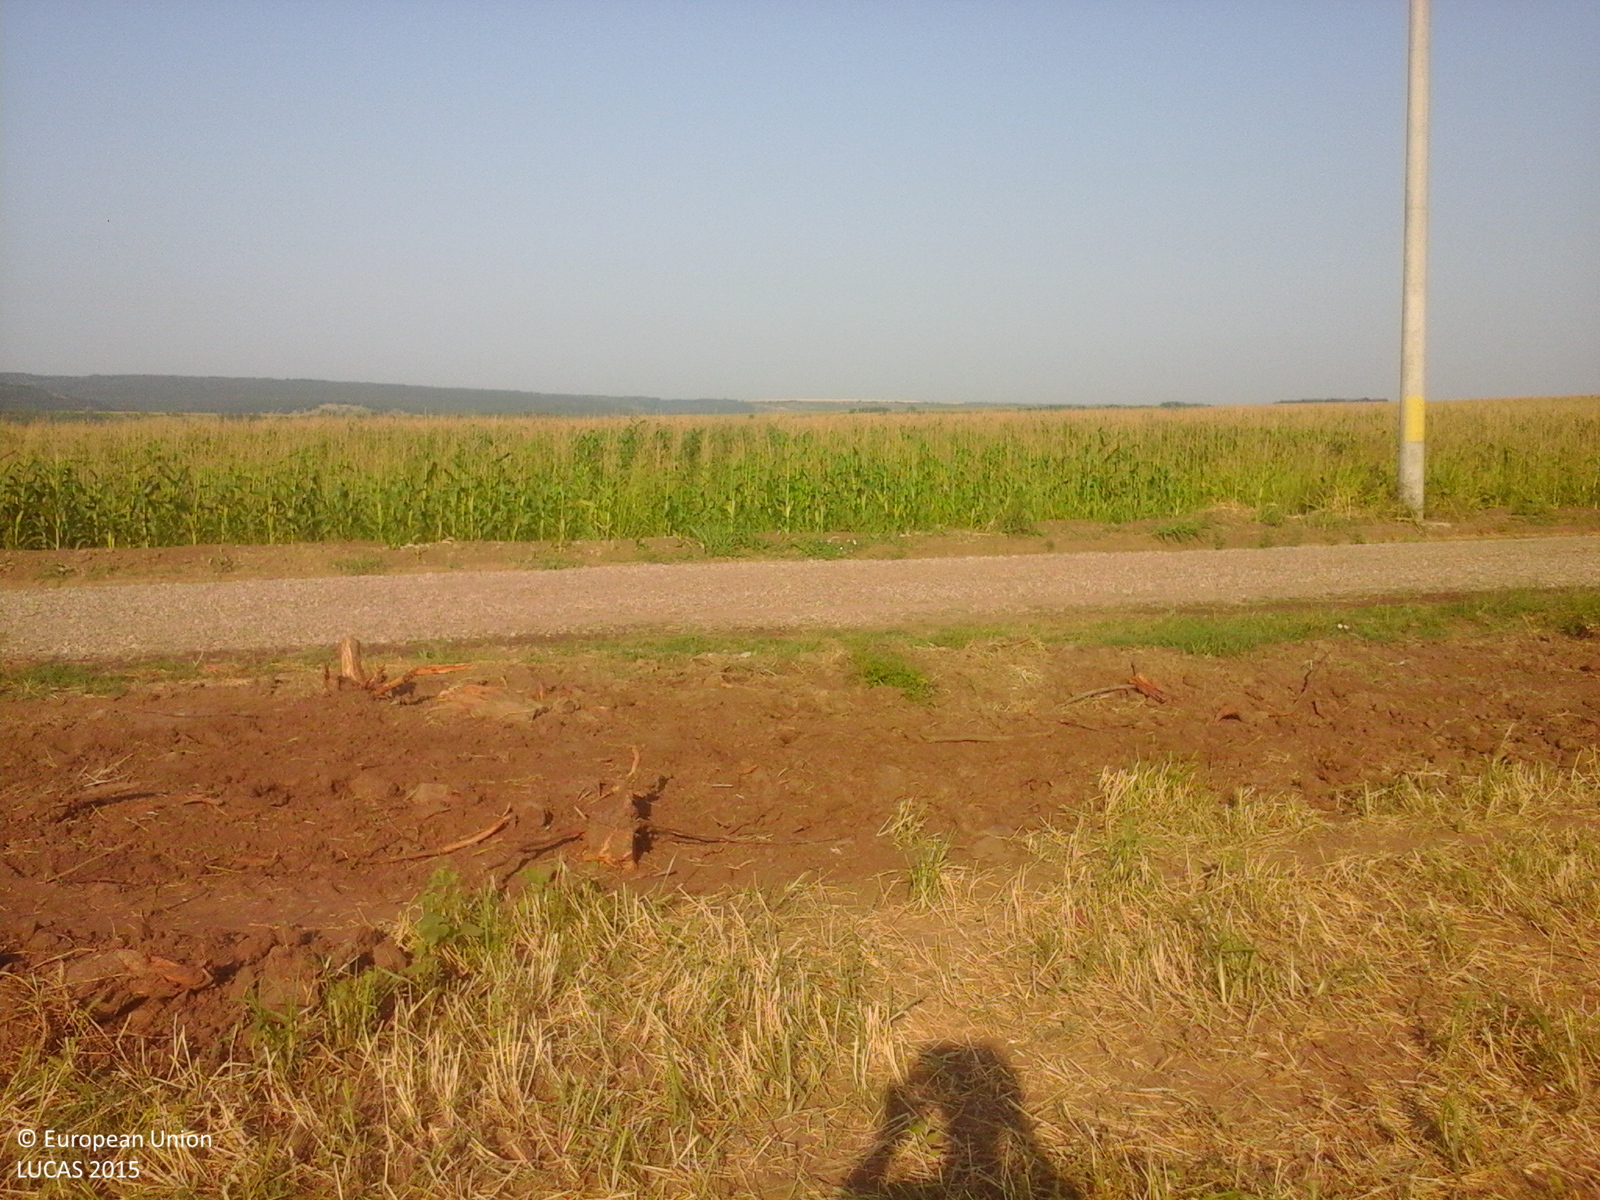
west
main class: Cropland
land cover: Durum wheat
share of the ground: > 75 %
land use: Agriculture (excluding fallow land and kitchen gardens)
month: July
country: RO
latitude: 45.9918
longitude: 28.0833
